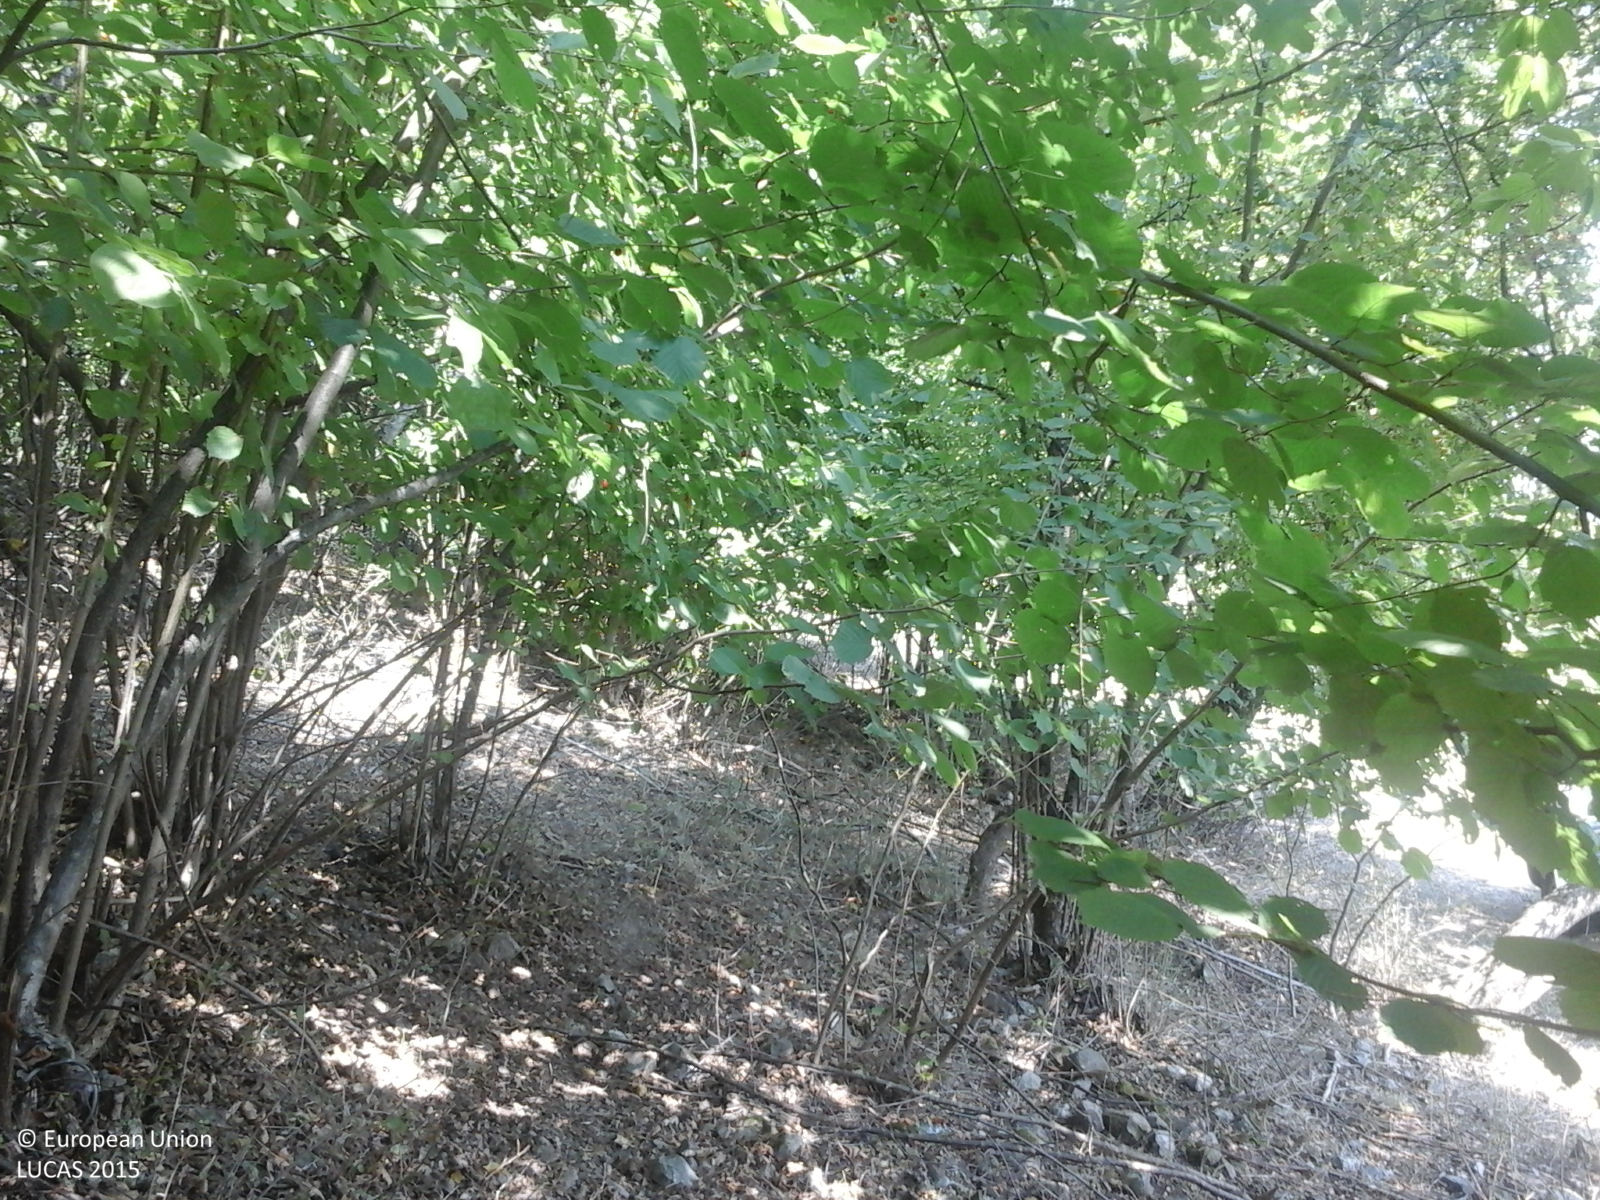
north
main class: Woodland
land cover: Broadleaved woodland
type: broadleaved evergreen forest
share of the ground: > 75 %
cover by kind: broadleaved forest trees 100 %
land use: Forestry
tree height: > 5 m
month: August
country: RO
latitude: 46.1313
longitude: 22.7502
